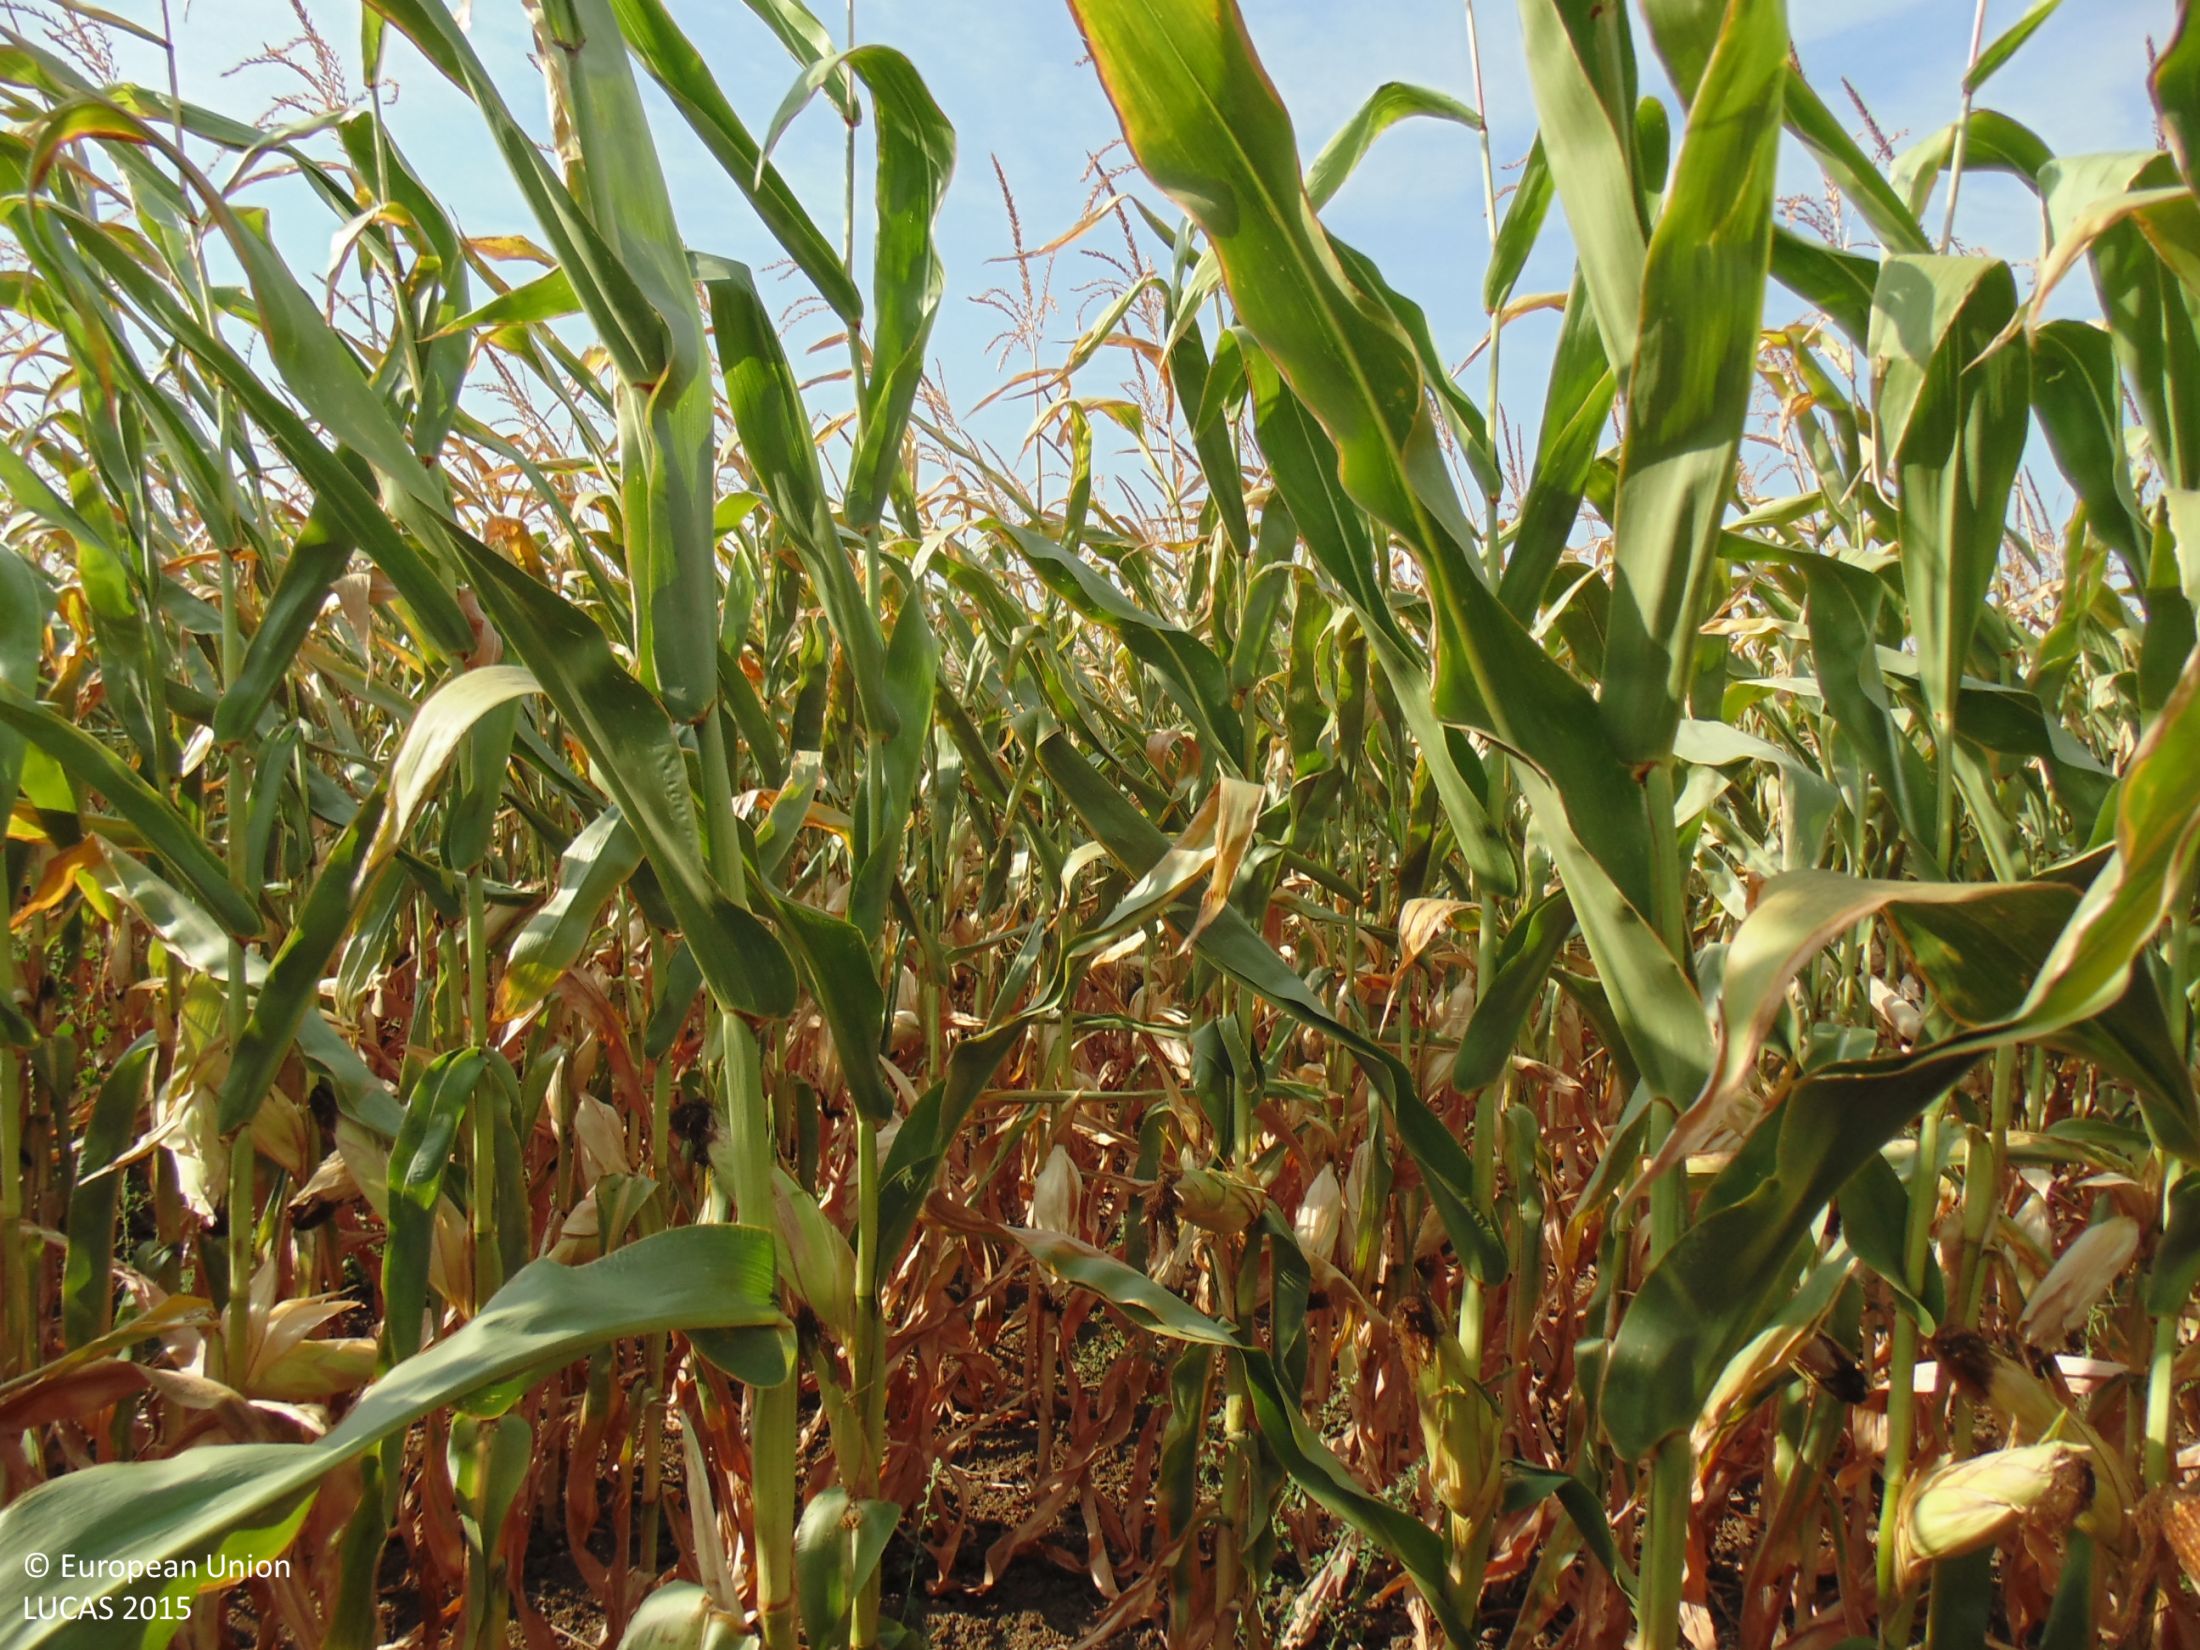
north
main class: Cropland
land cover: Maize
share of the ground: > 75 %
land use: Agriculture (excluding fallow land and kitchen gardens)
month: August
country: BG
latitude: 43.7268
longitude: 28.3713
